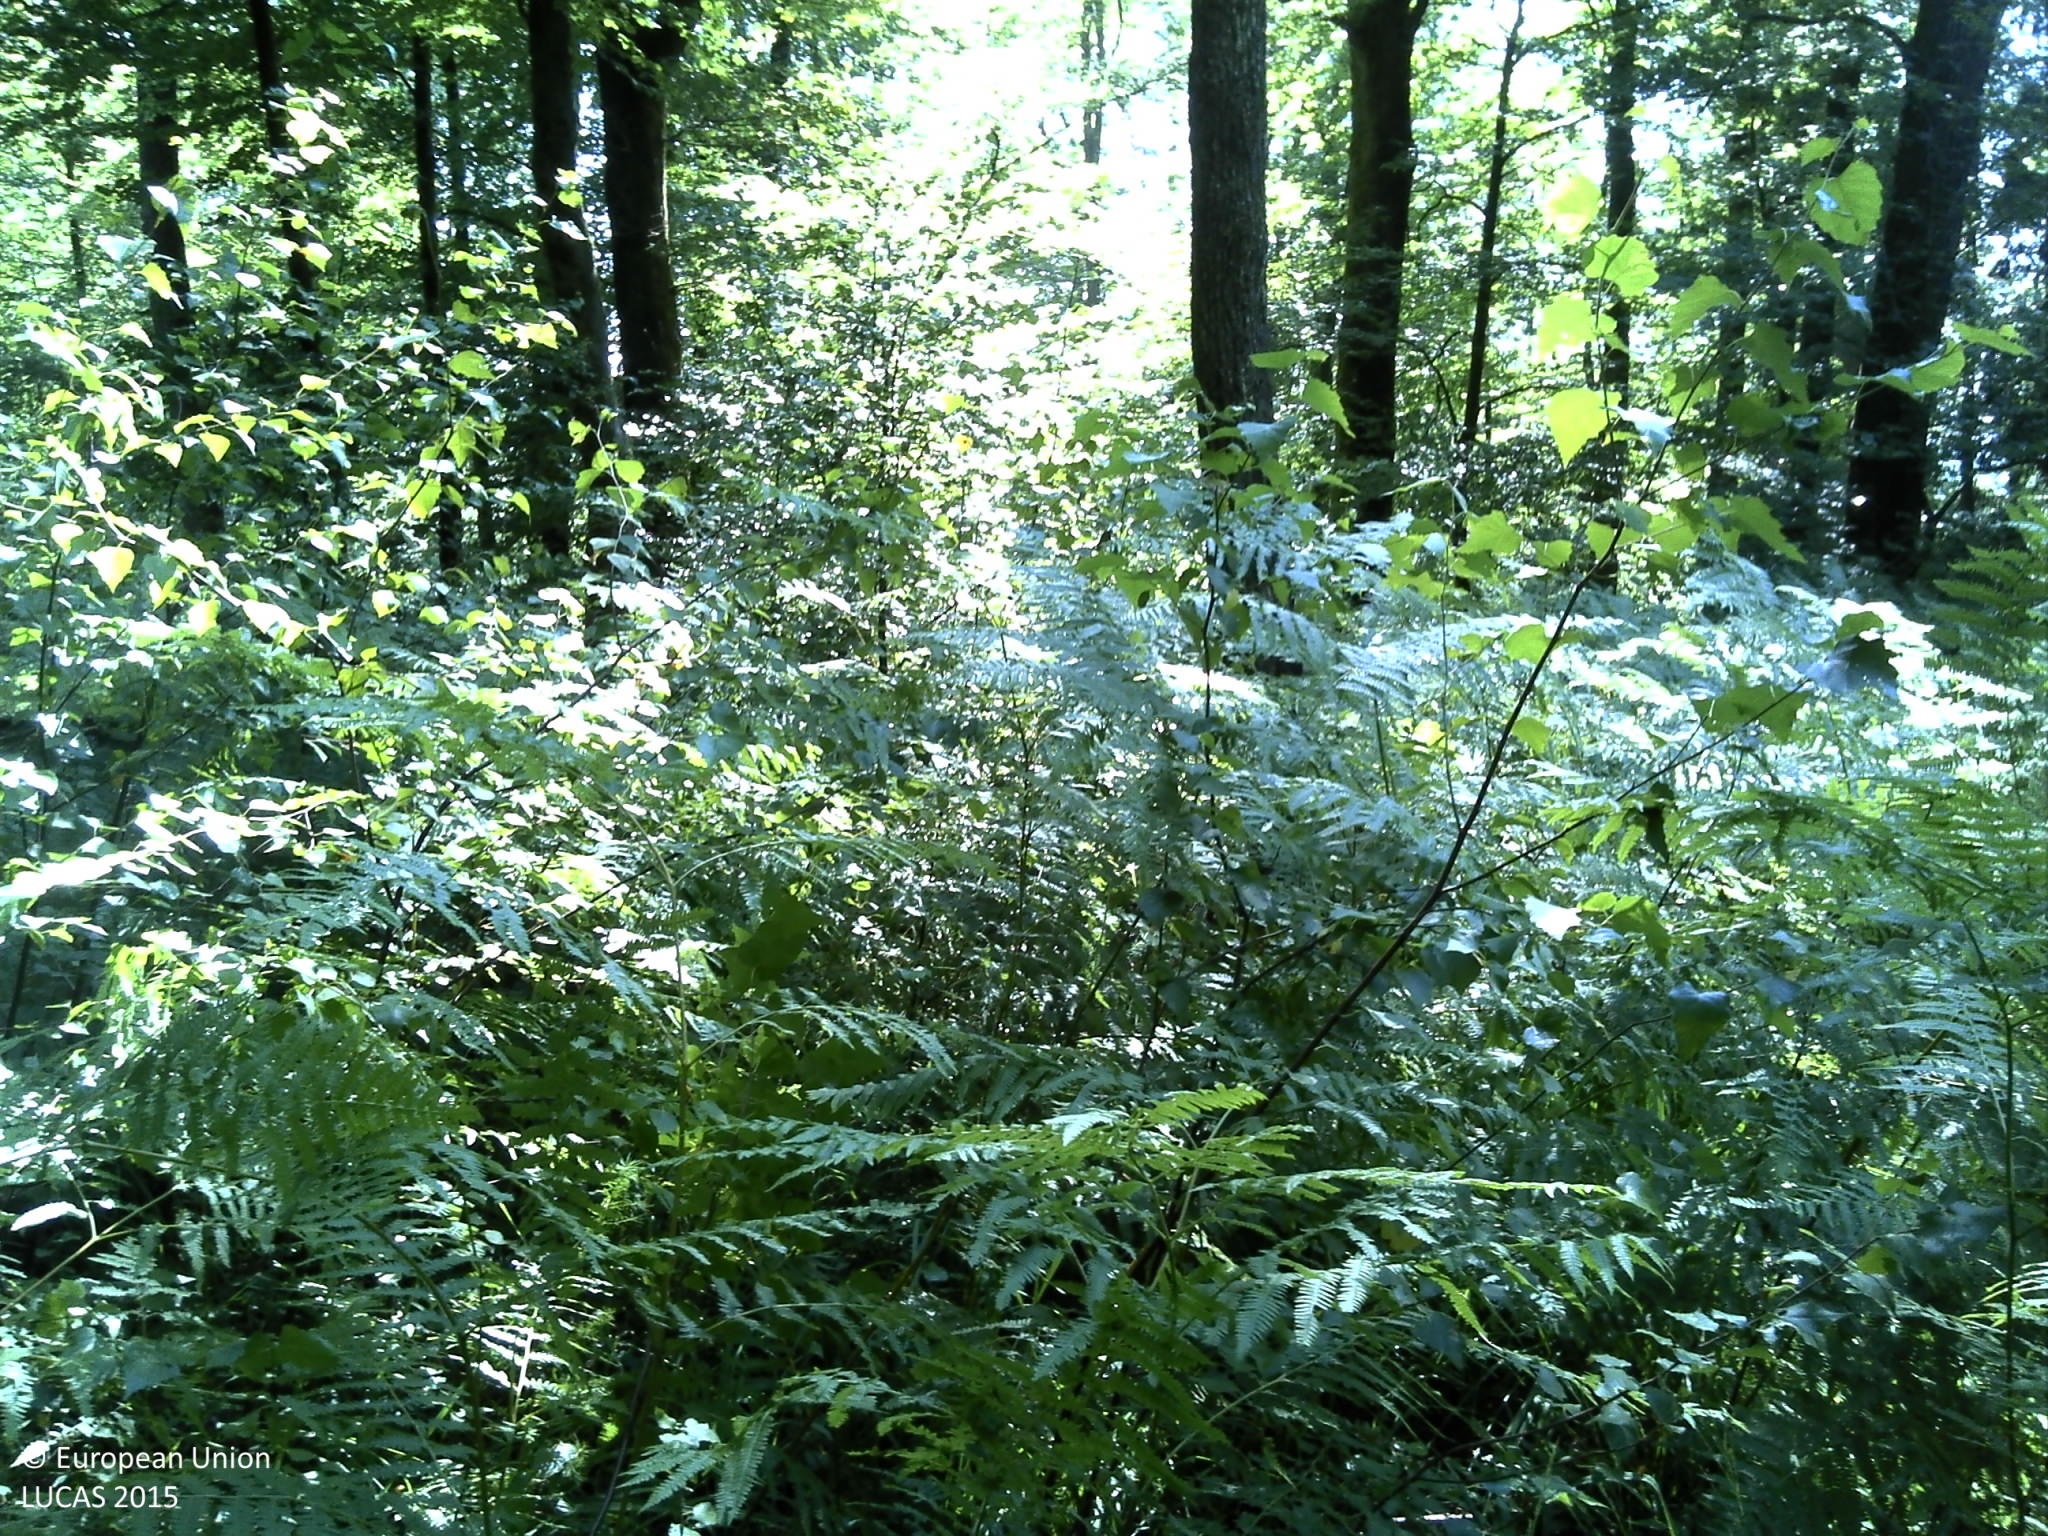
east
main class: Woodland
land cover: Broadleaved woodland
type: beech forest
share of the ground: > 75 %
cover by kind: broadleaved forest trees 100 %
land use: Forestry
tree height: > 5 m
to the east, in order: Broadleaved woodland; Grassland without tree/shrub cover; Broadleaved woodland; Fences; Grassland with sparse tree/shrub cover; Fences; Grassland without tree/shrub cover; Fences; Grassland with sparse tree/shrub cover
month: July
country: FR
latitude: 48.1154
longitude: 6.0110
